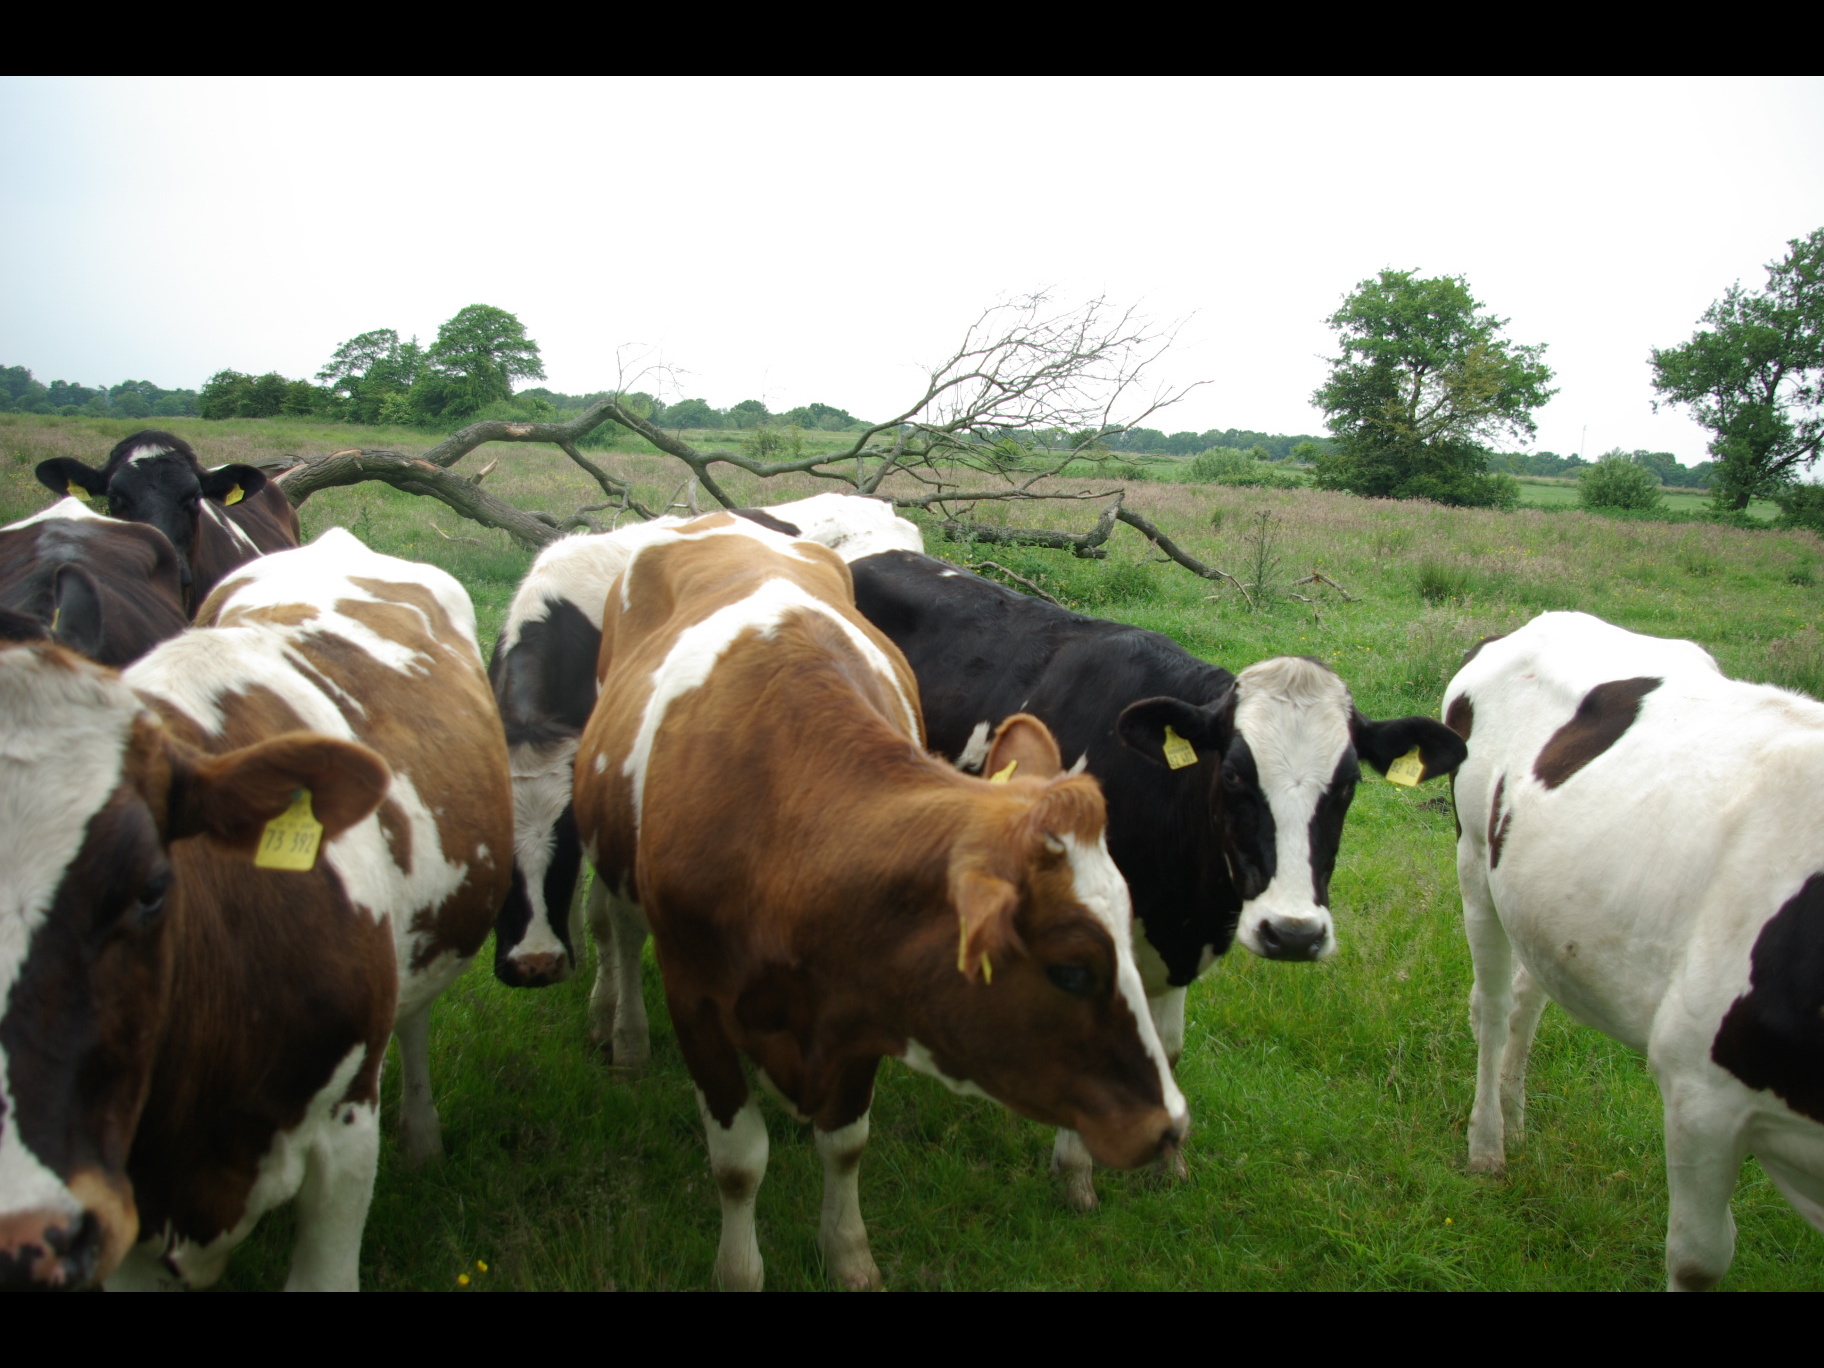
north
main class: Grassland
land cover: Grassland without tree/shrub cover
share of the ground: > 75 %
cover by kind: herbaceous plants 100 %
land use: Agriculture (excluding fallow land and kitchen gardens)
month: June
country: DE
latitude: 54.5341
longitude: 9.8919
